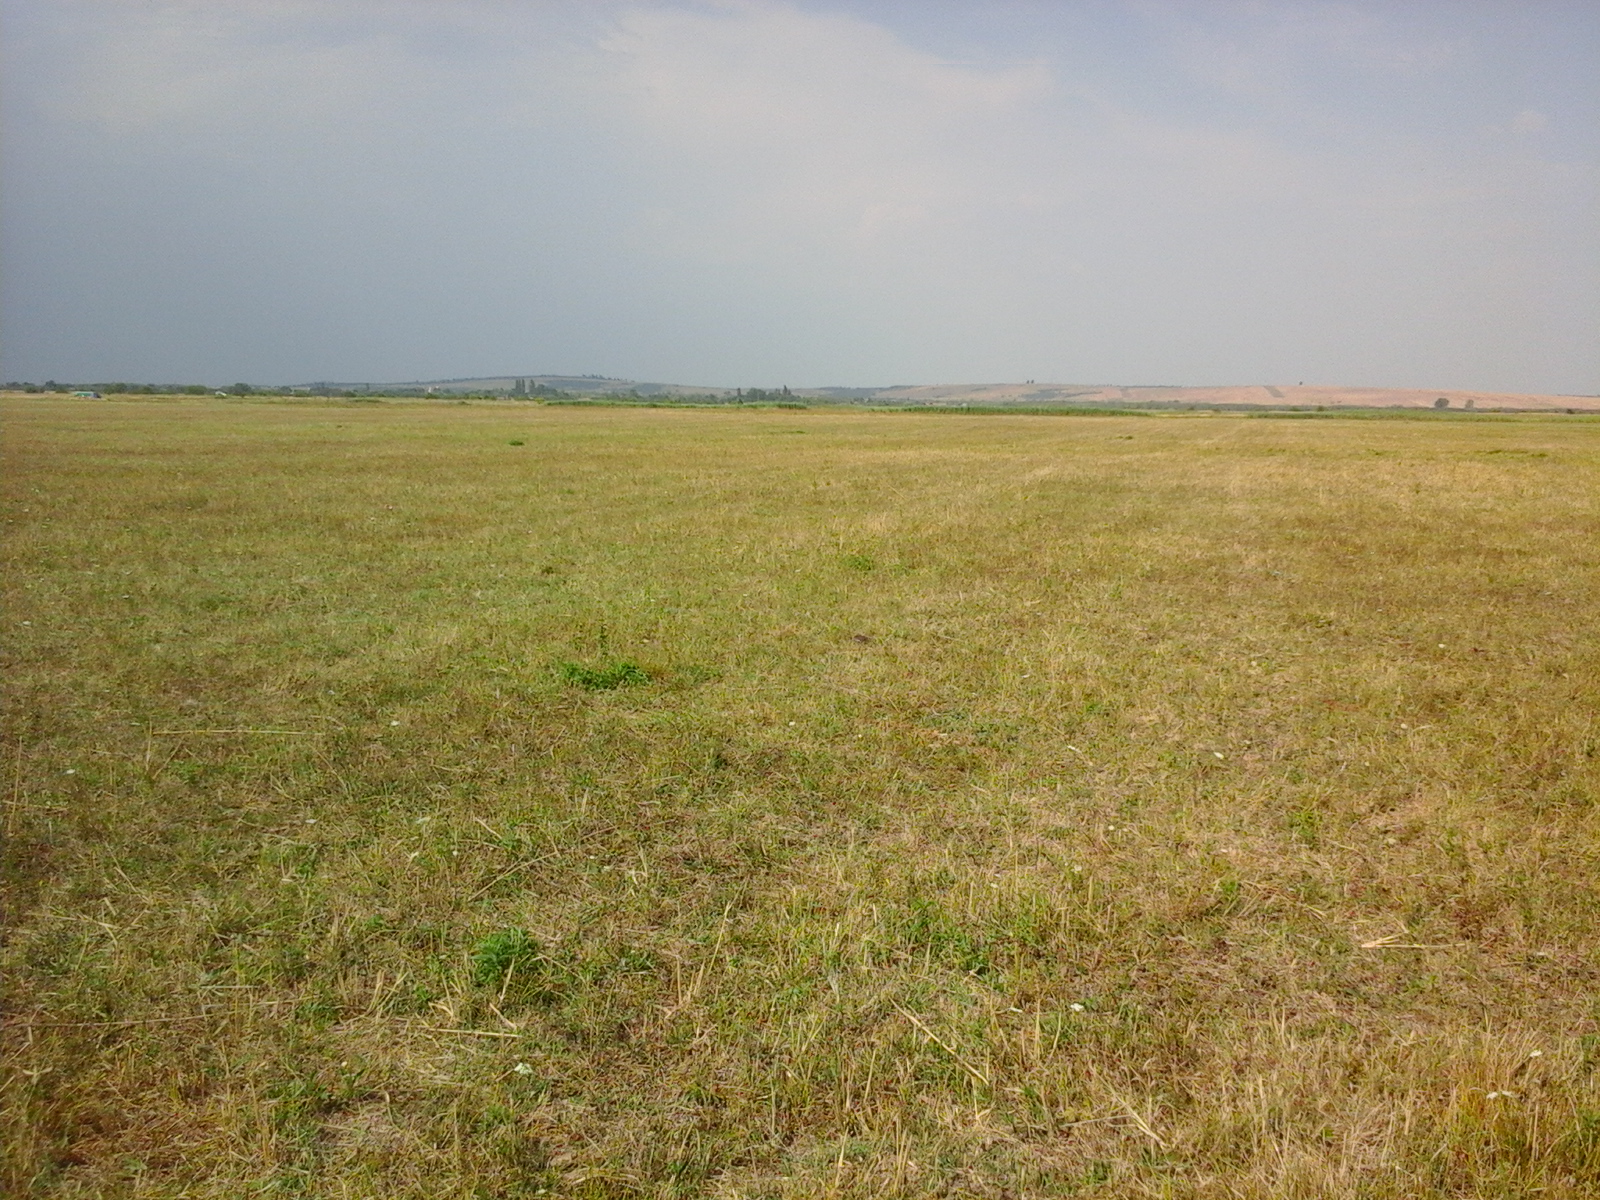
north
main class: Grassland
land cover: Grassland without tree/shrub cover
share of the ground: > 75 %
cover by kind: herbaceous plants 100 %
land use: Agriculture (excluding fallow land and kitchen gardens)
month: August
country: RO
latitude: 44.4460
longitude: 22.6685
